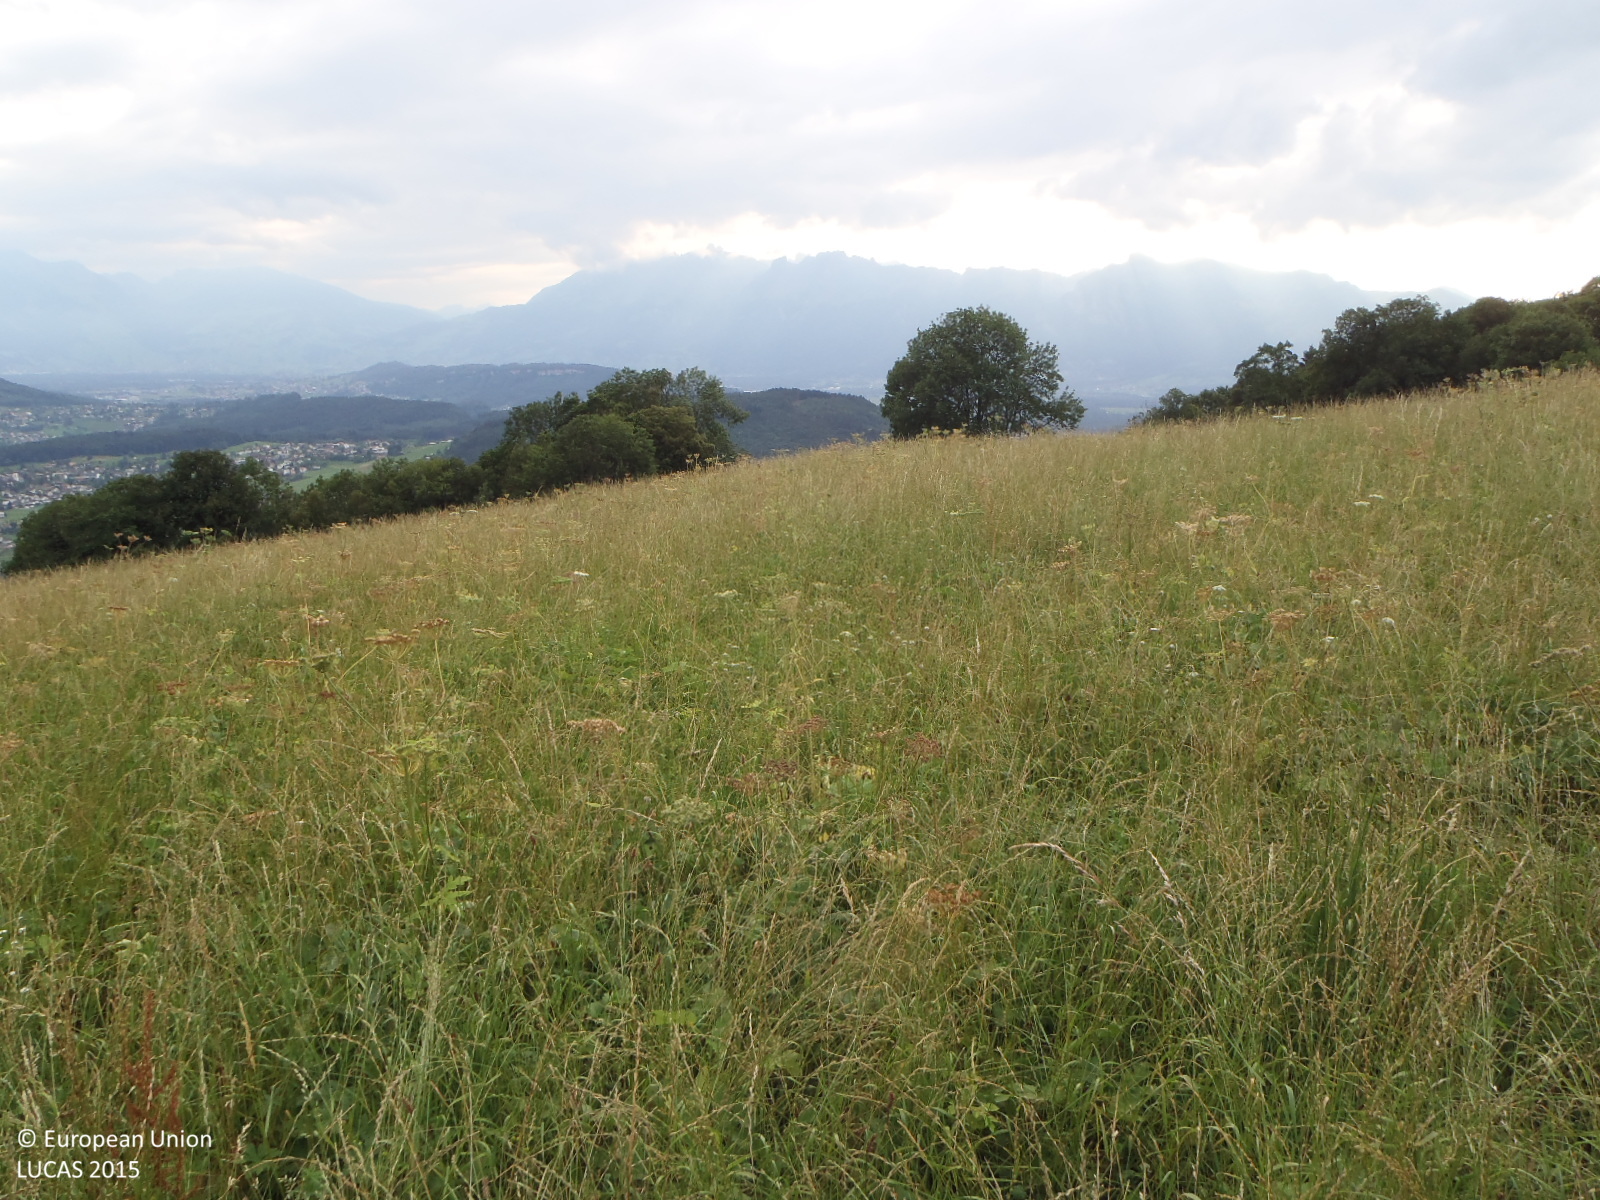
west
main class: Grassland
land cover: Grassland without tree/shrub cover
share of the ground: > 75 %
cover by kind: herbaceous plants 100 %
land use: Agriculture (excluding fallow land and kitchen gardens)
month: July
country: AT
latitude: 47.2511
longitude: 9.6700
